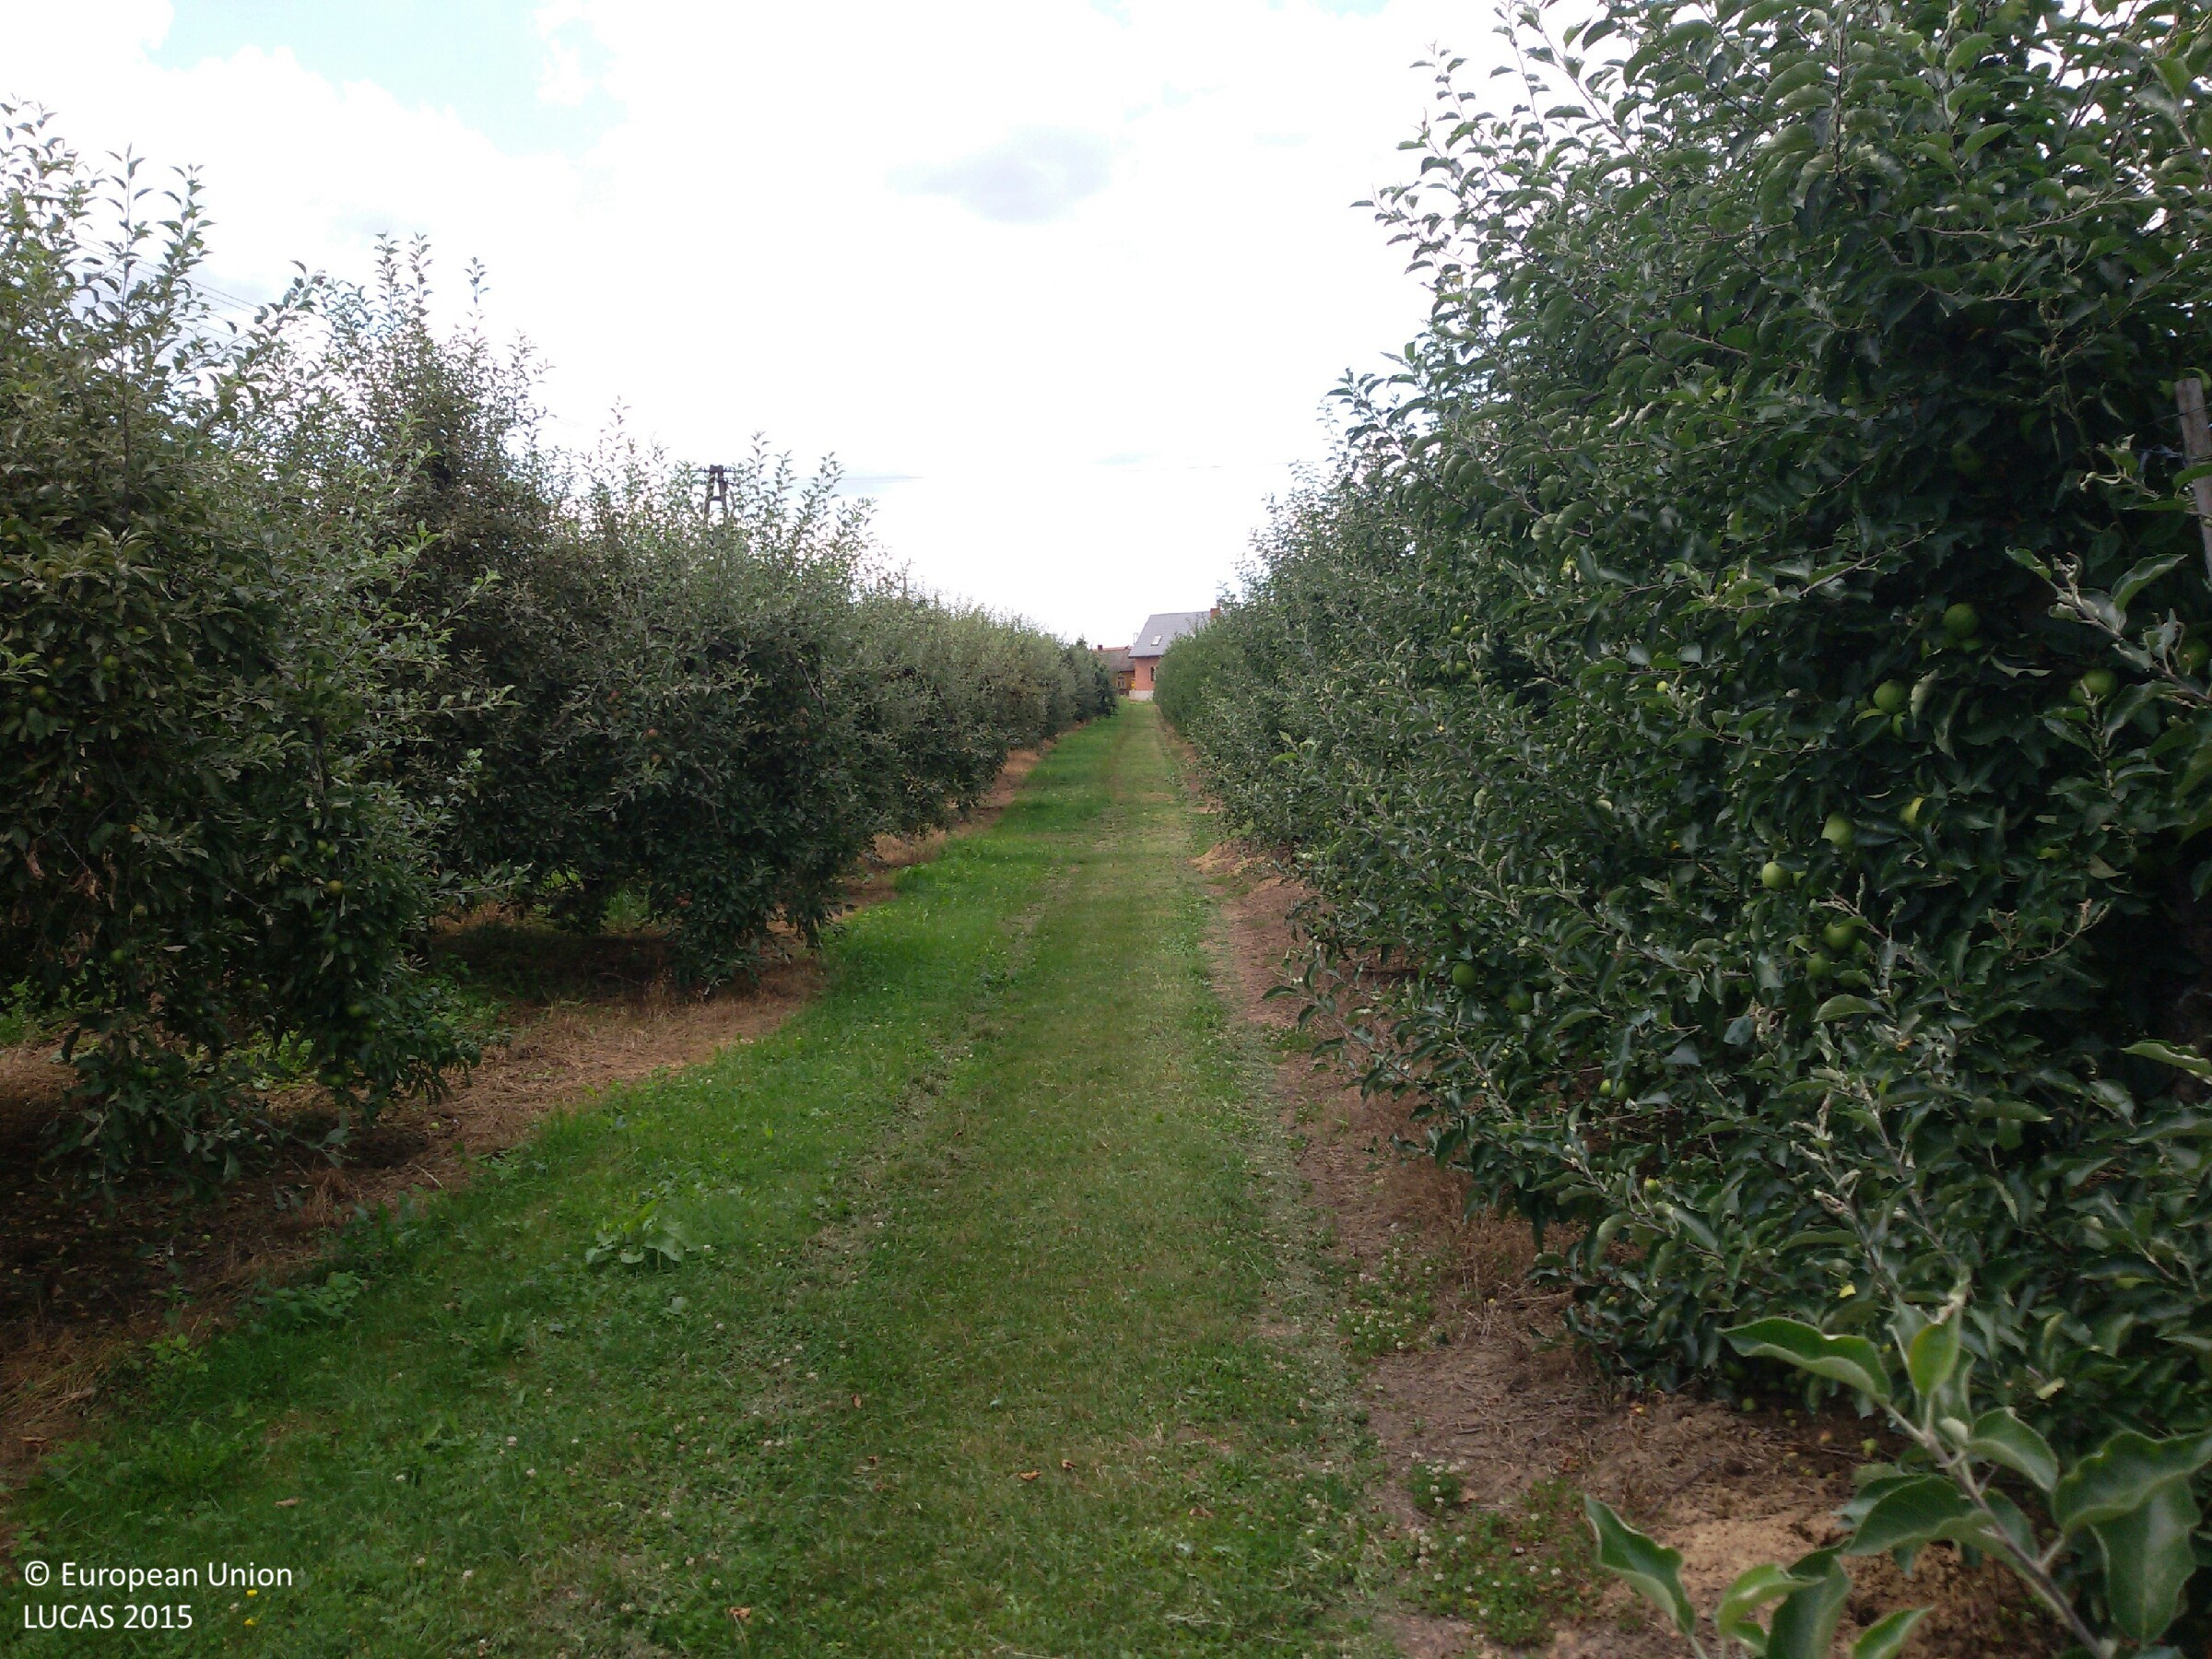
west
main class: Cropland
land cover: Apple fruit
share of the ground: > 75 %
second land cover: Grassland without tree/shrub cover
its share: > 75 %
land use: Agriculture (excluding fallow land and kitchen gardens)
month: July
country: PL
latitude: 50.5843
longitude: 21.6483
